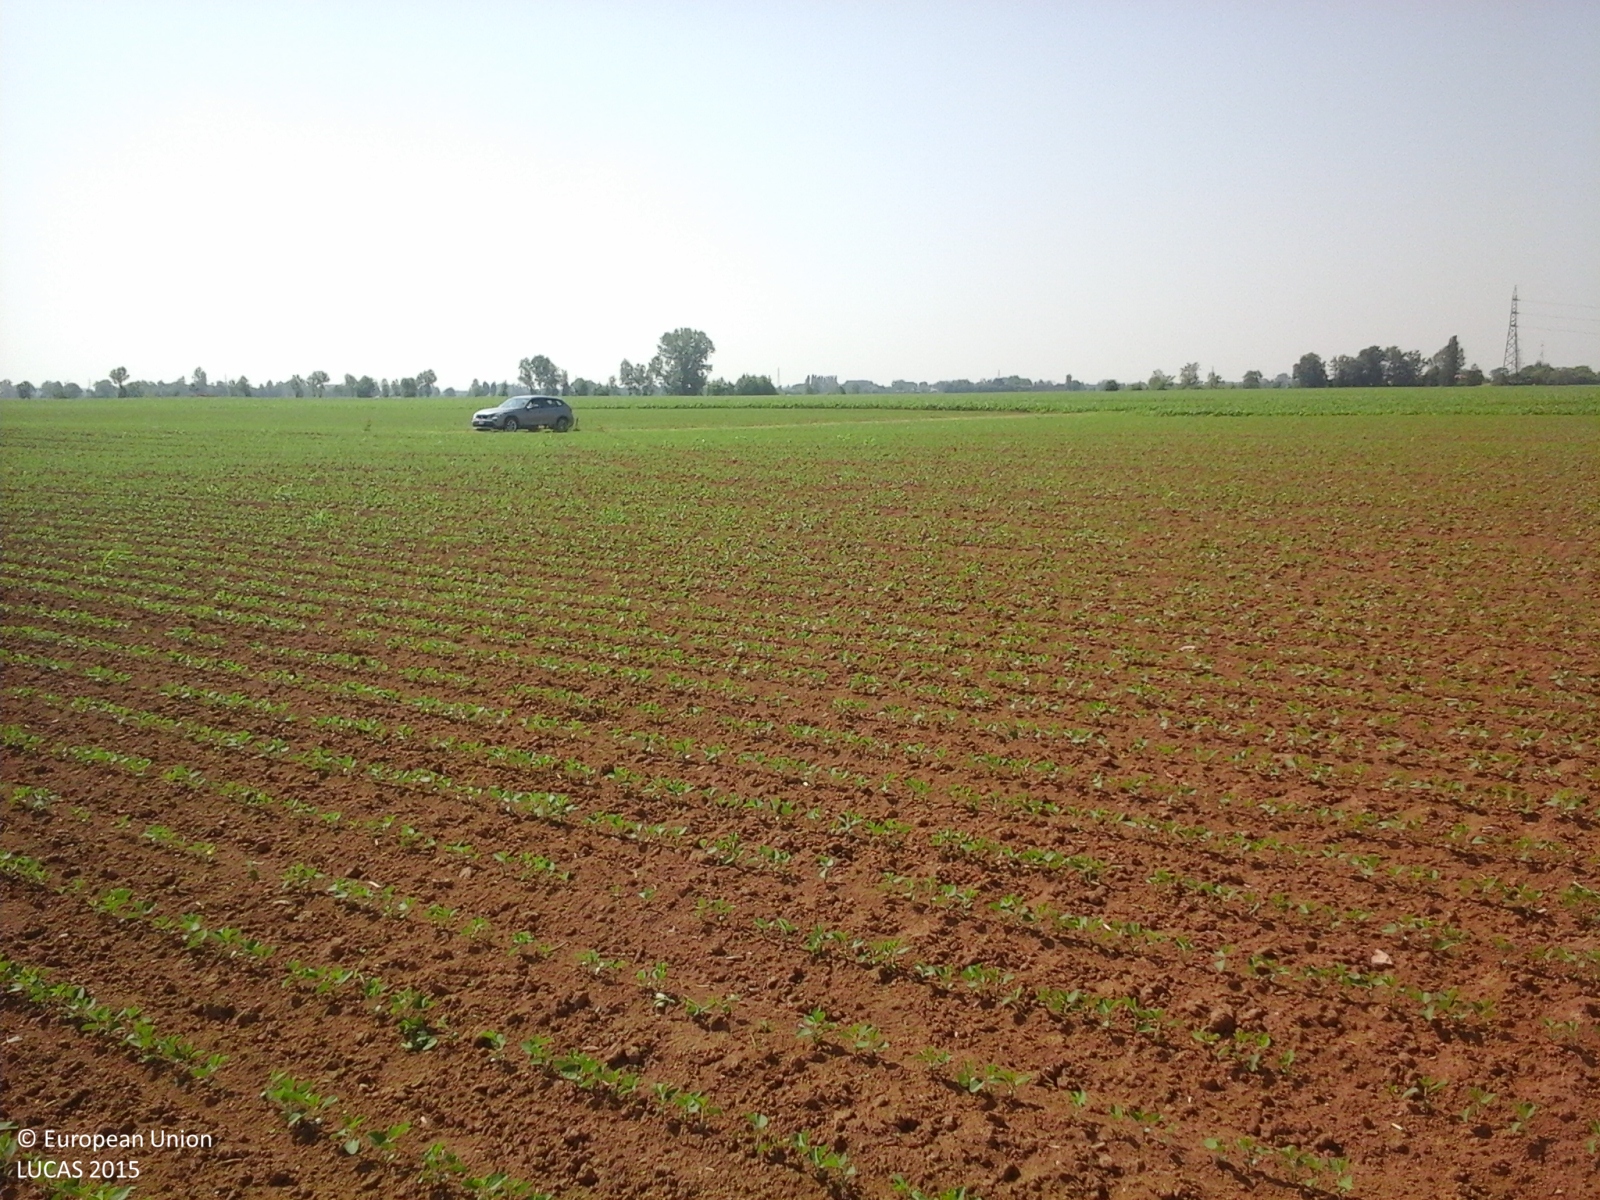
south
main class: Cropland
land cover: Soya
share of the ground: < 10 %
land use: Agriculture (excluding fallow land and kitchen gardens)
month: May
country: IT
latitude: 45.1601
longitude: 10.6222
